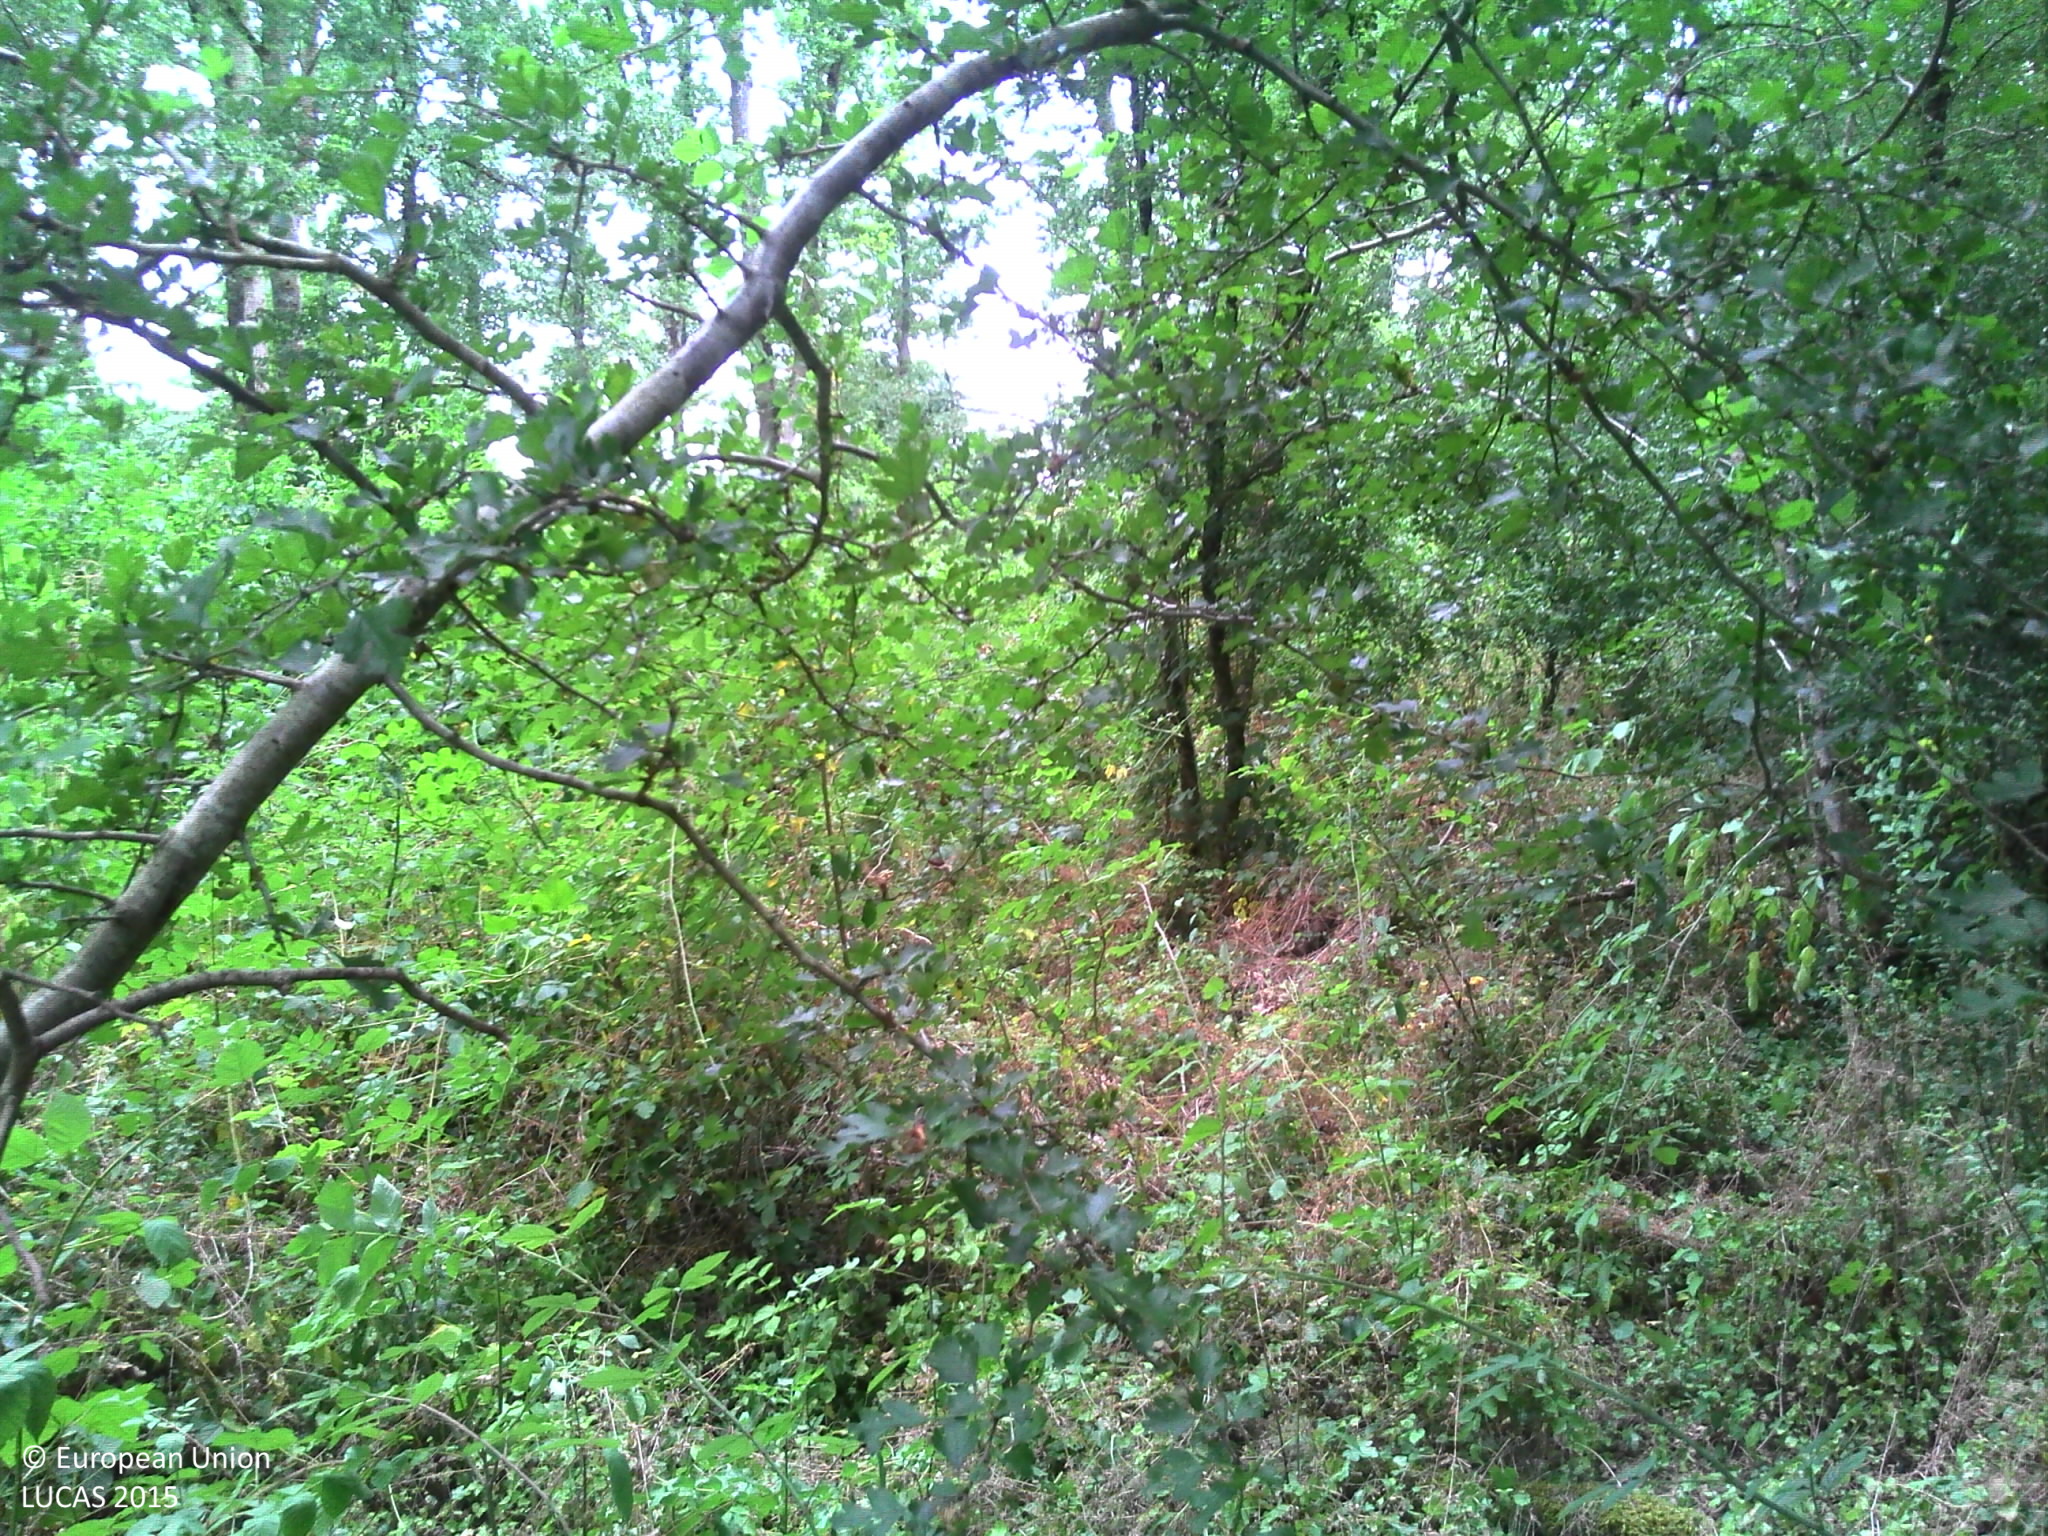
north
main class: Woodland
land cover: Broadleaved woodland
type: mesophytic deciduous forest
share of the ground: > 75 %
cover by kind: broadleaved forest trees 100 %
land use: Forestry
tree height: > 5 m
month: July
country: FR
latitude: 47.9000
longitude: 2.8358
